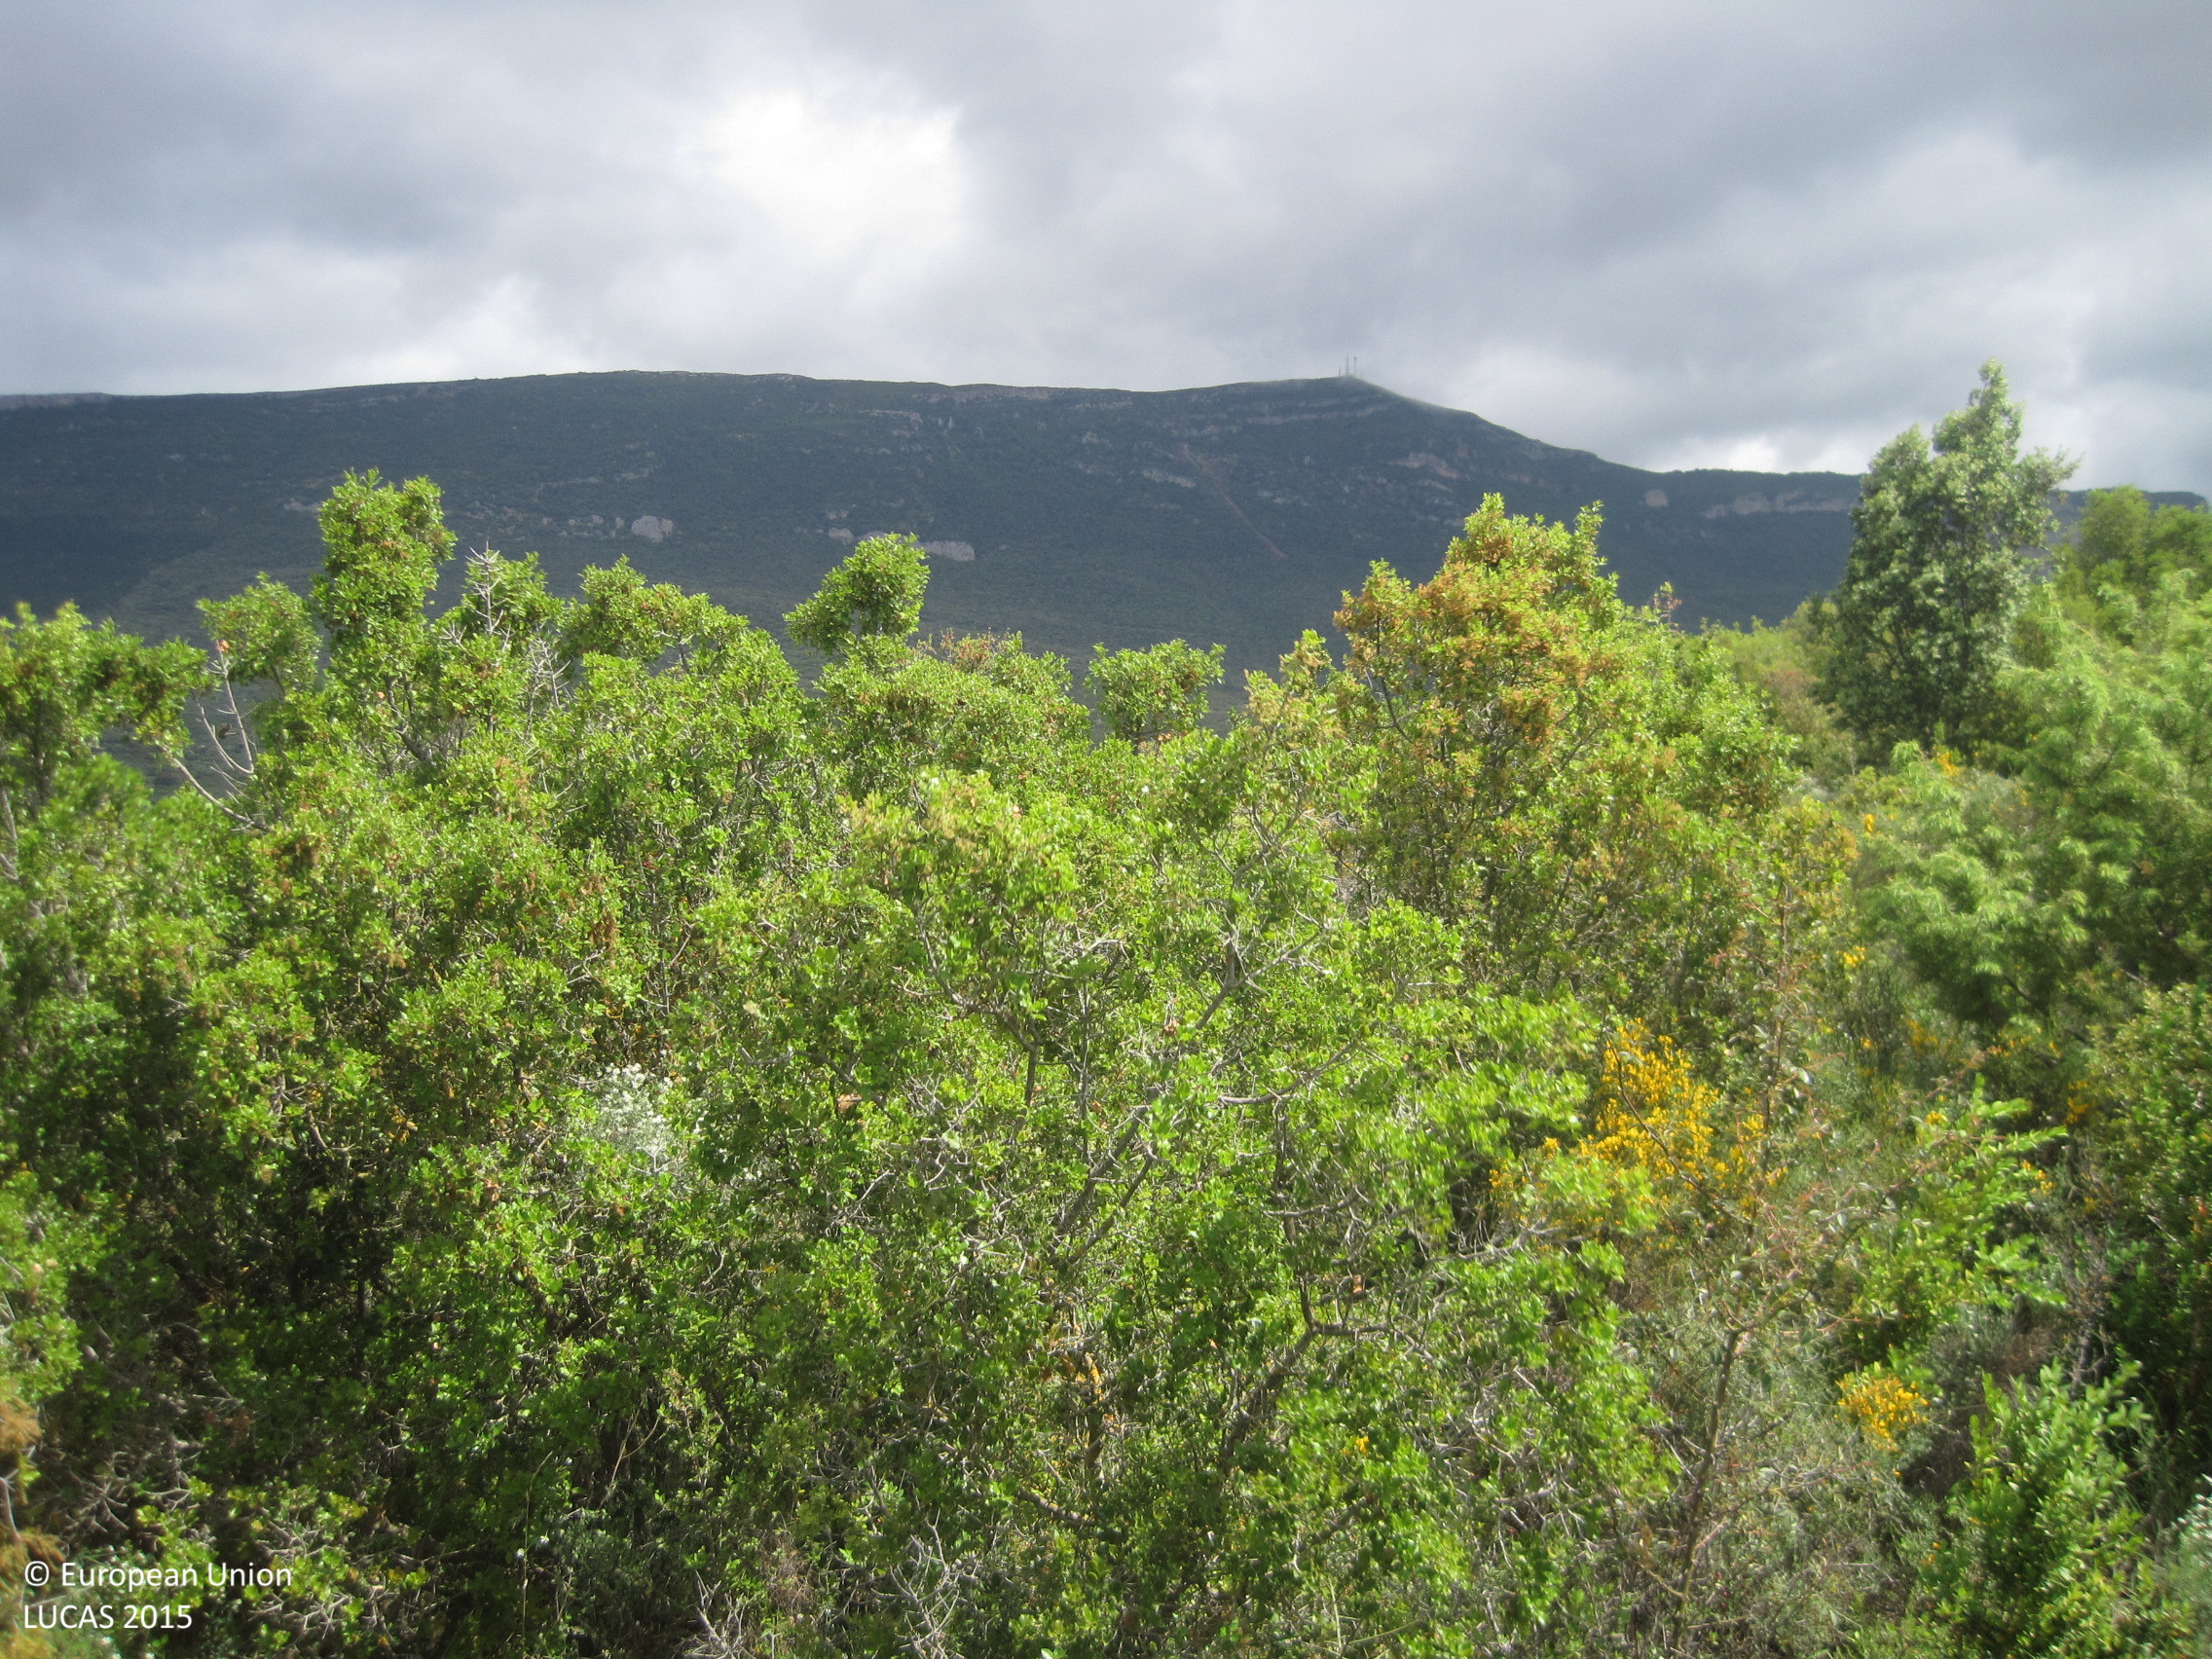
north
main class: Shrubland
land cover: Shrubland with sparse tree cover
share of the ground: > 75 %
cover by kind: shrubs 90 %, broadleaved forest trees 5 %, herbaceous plants 5 %
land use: Semi-natural and natural areas not in use
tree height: > 5 m
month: May
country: ES
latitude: 42.6124
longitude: -1.2117
